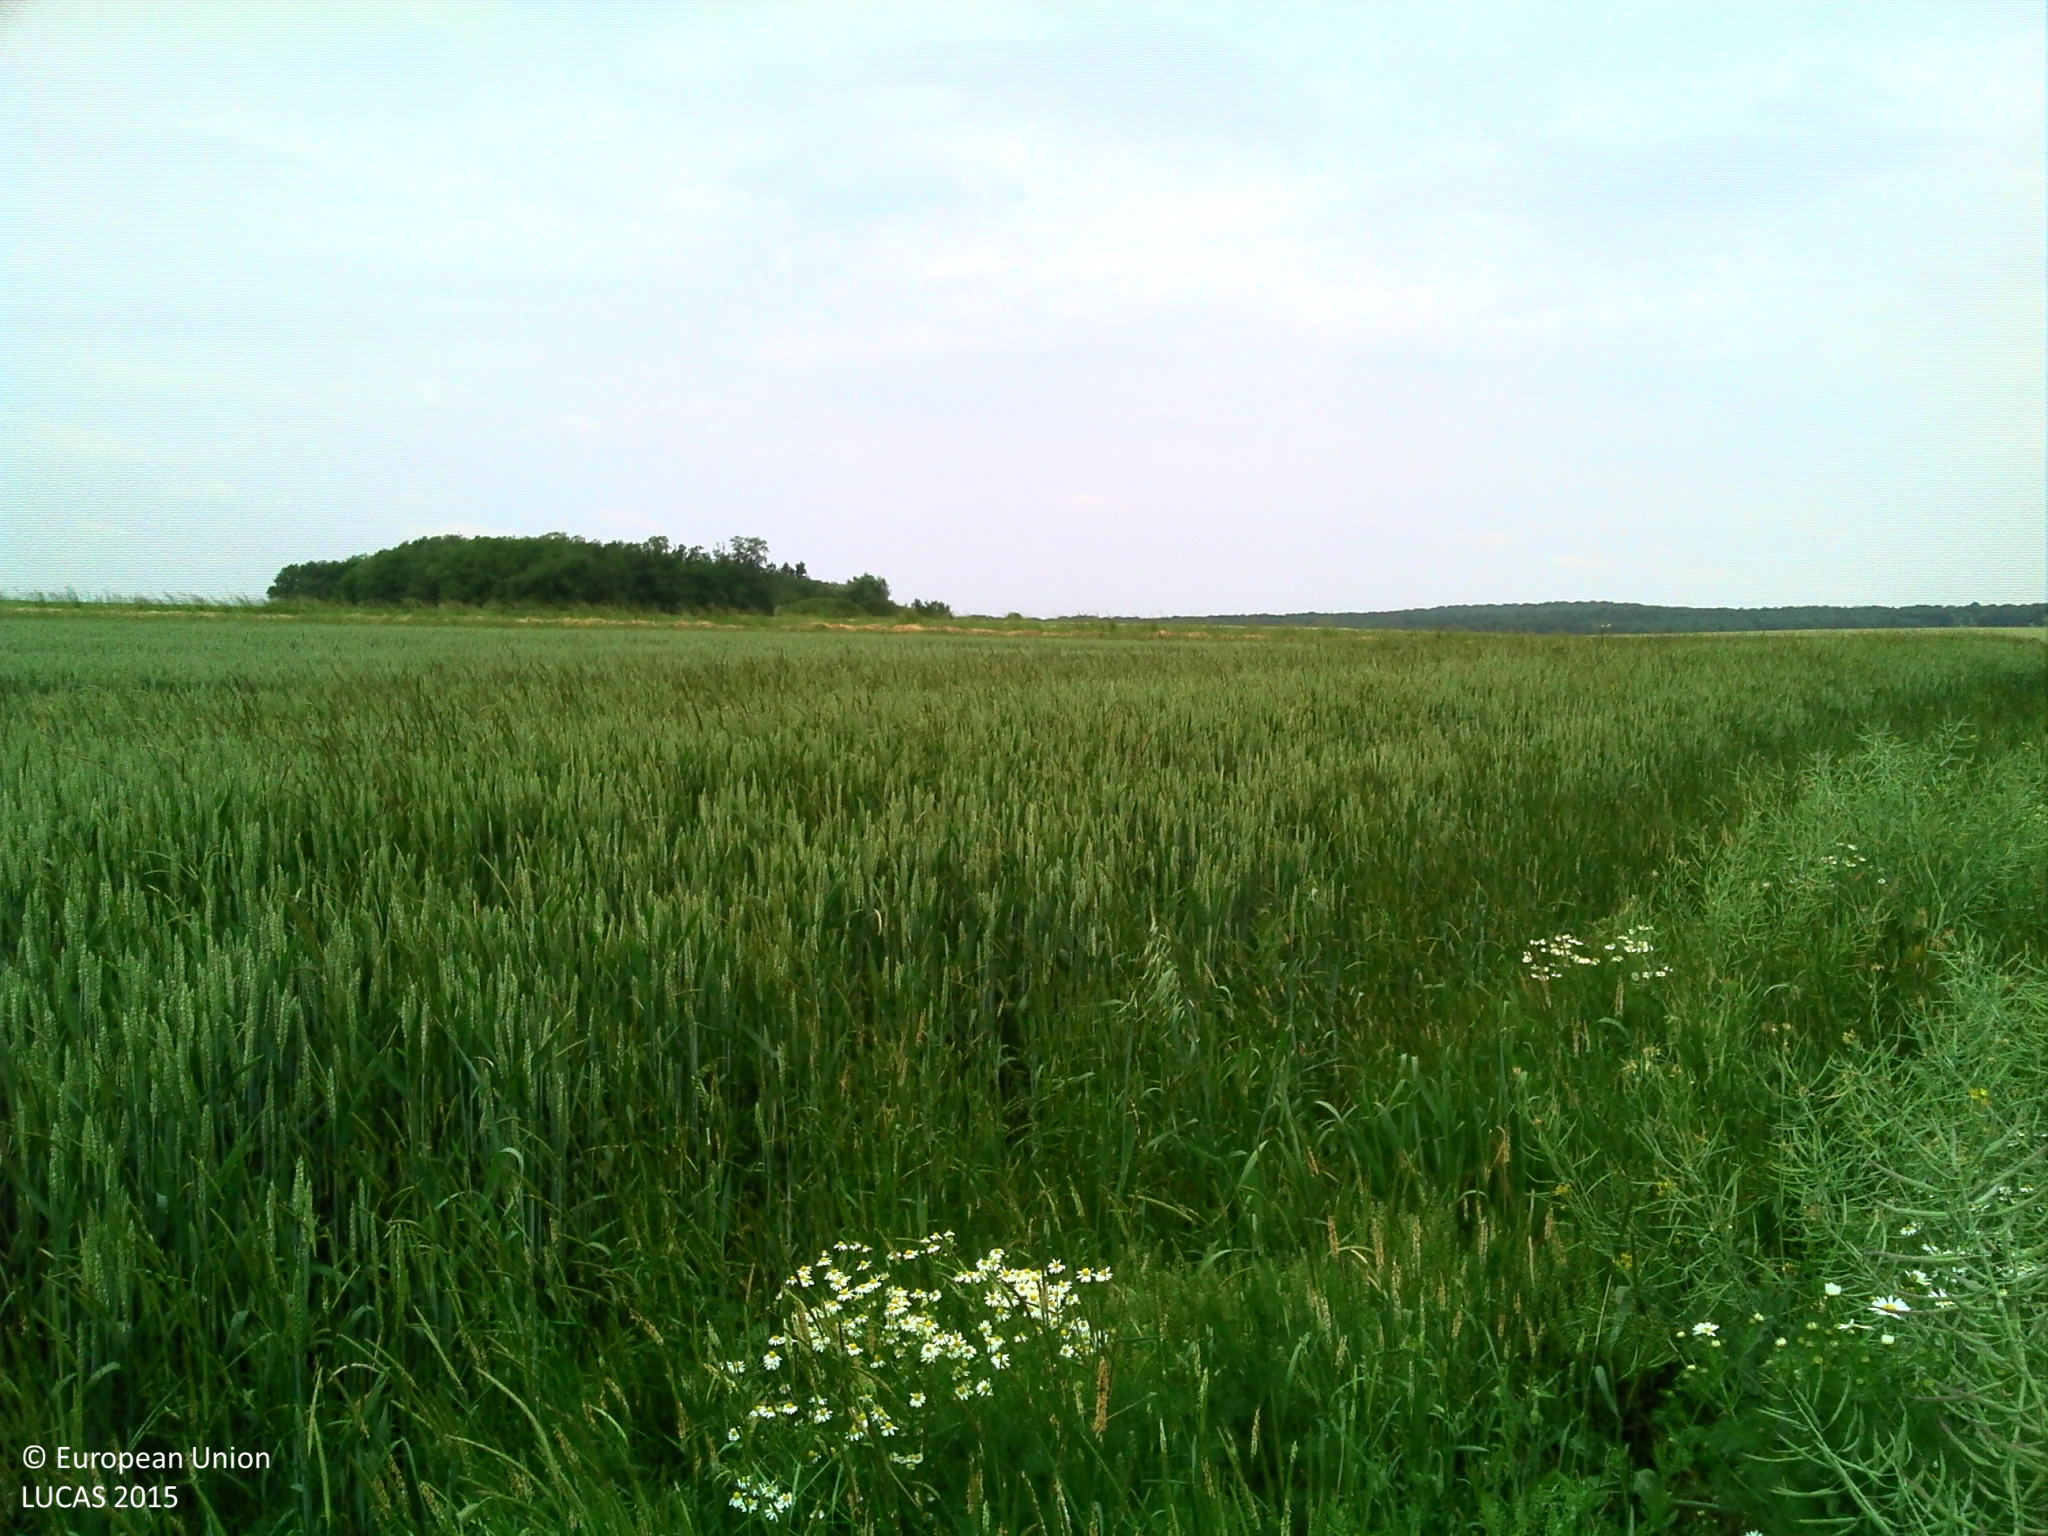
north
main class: Cropland
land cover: Rape and turnip rape
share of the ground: > 75 %
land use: Agriculture (excluding fallow land and kitchen gardens)
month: June
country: FR
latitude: 48.5182
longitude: 6.1958
